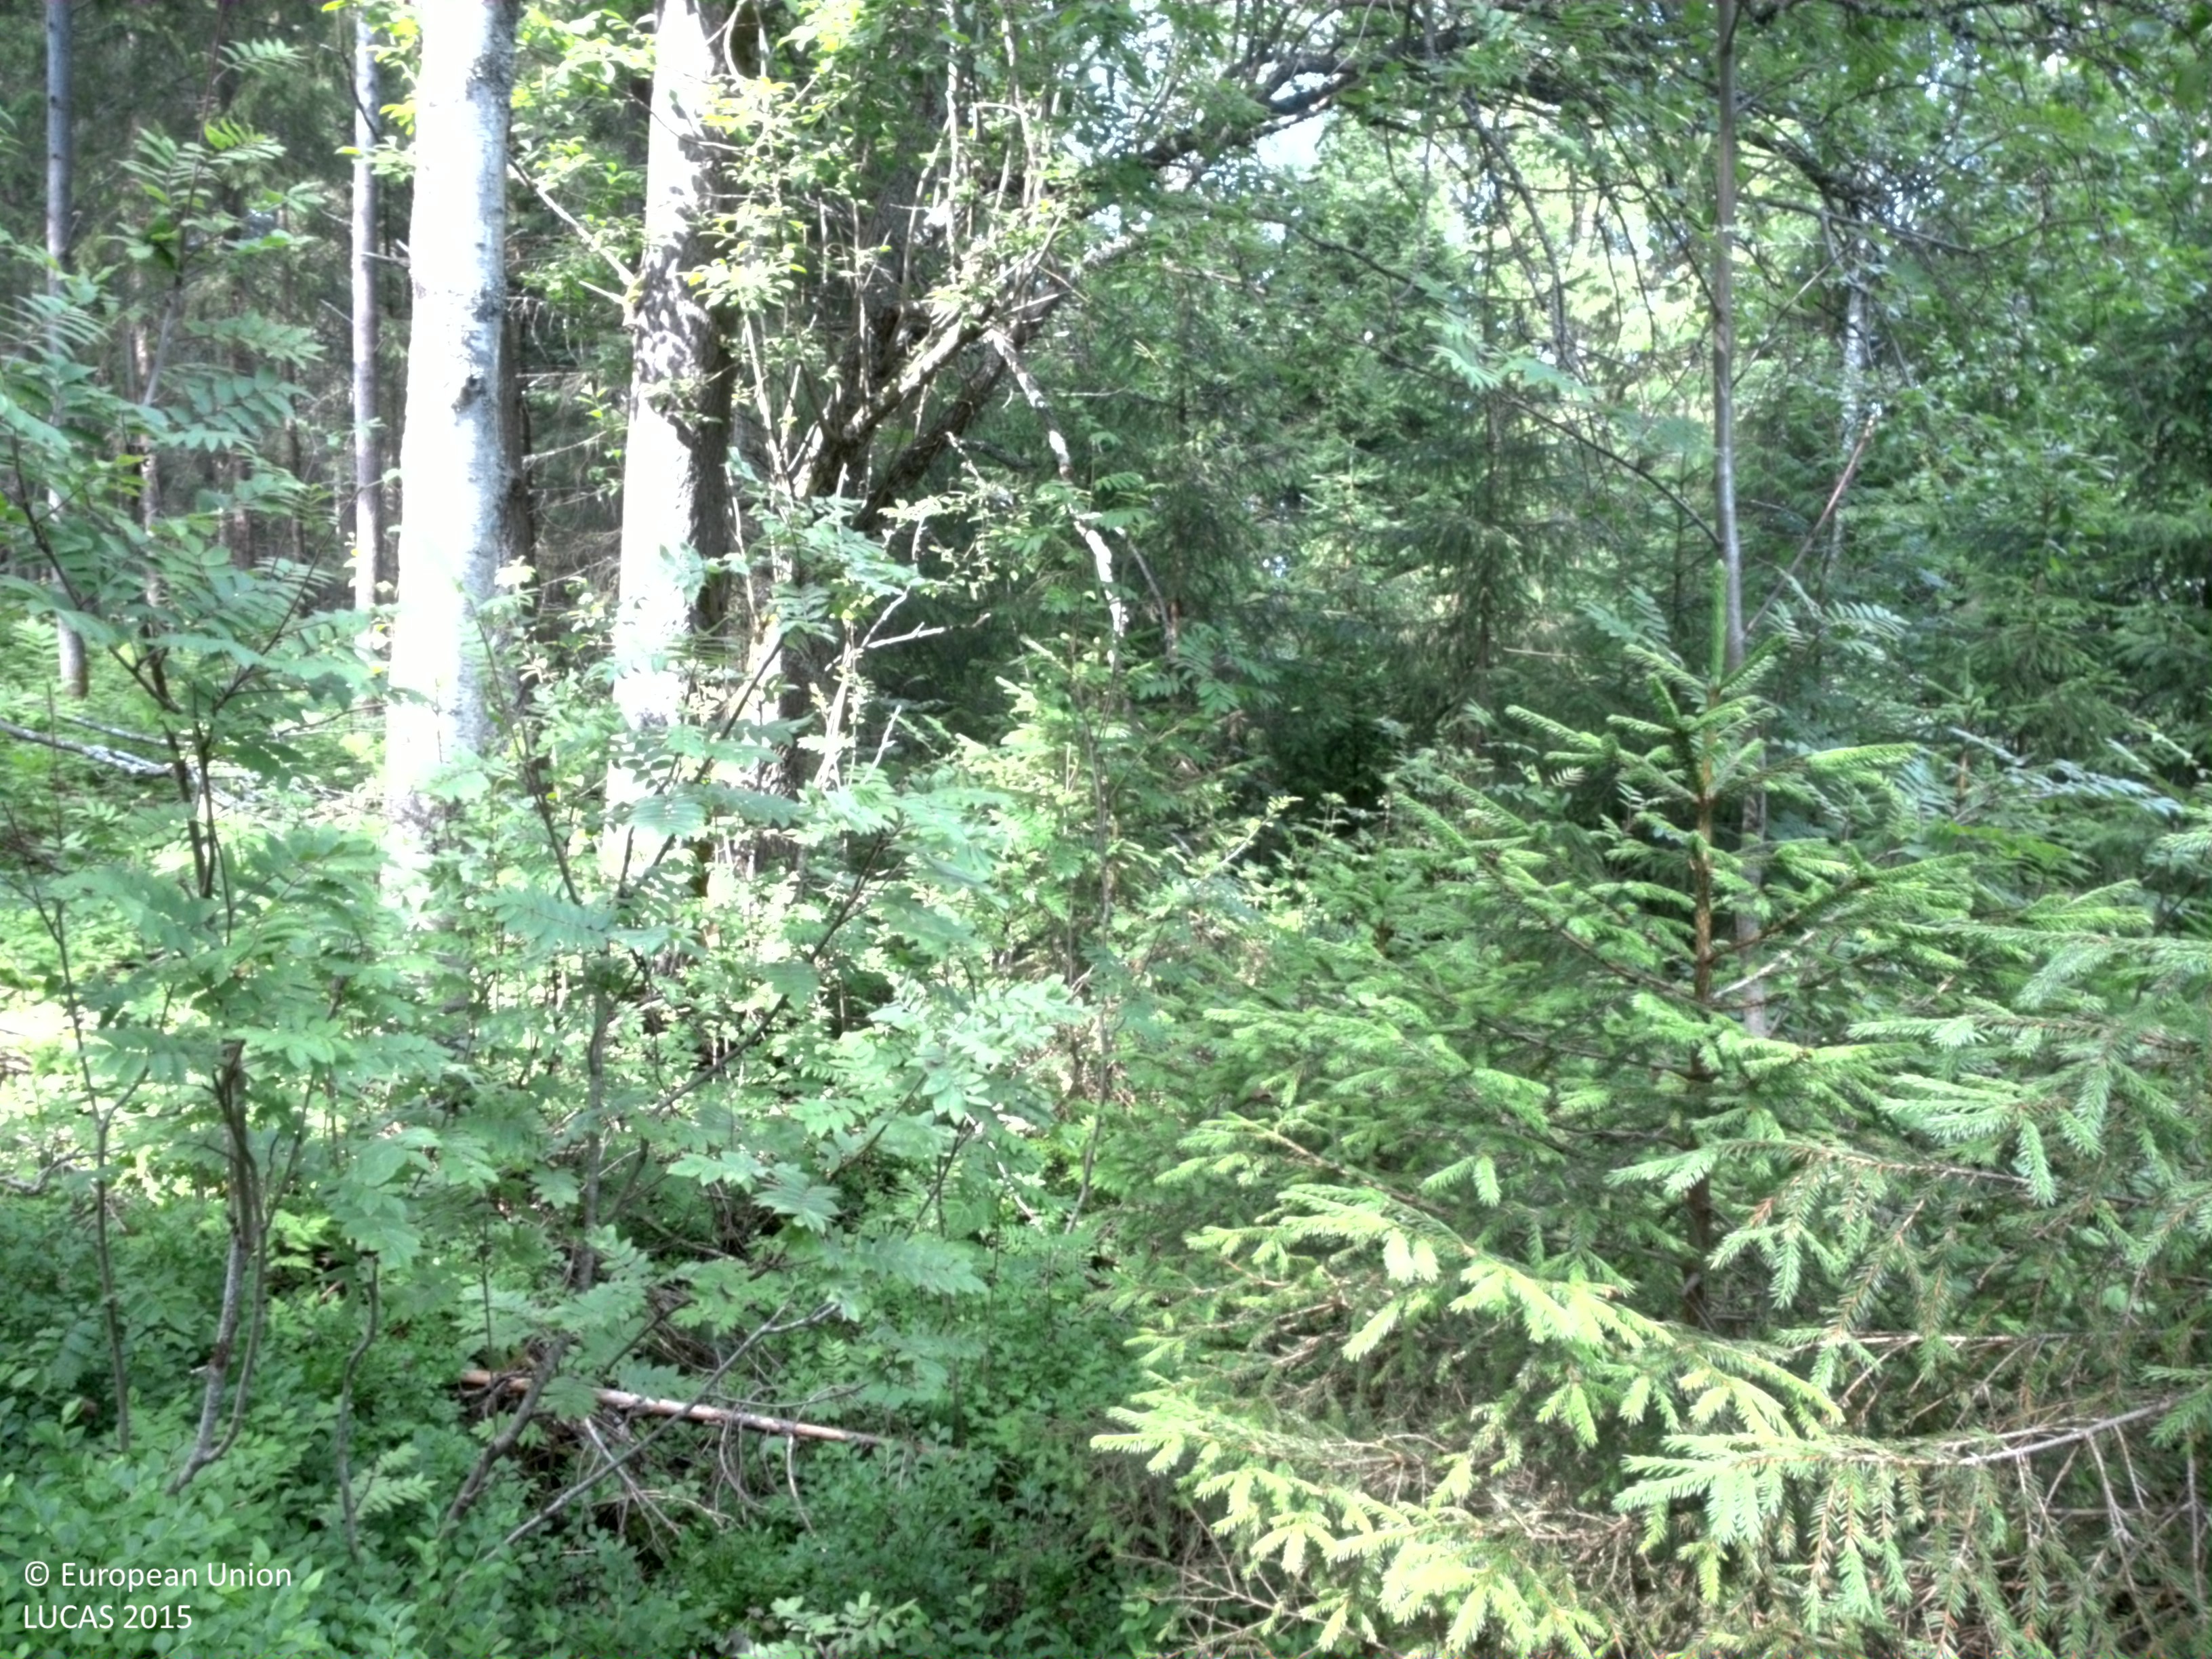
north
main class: Woodland
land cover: Spruce dominated coniferous woodland
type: boreal forest
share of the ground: 50 - 75 %
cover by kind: coniferous forest trees 70 %, shrubs 25 %, broadleaved forest trees 5 %
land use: Forestry
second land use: Amenities, museums, leisure
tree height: > 5 m
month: July
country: SE
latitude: 64.4350
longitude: 21.2614
